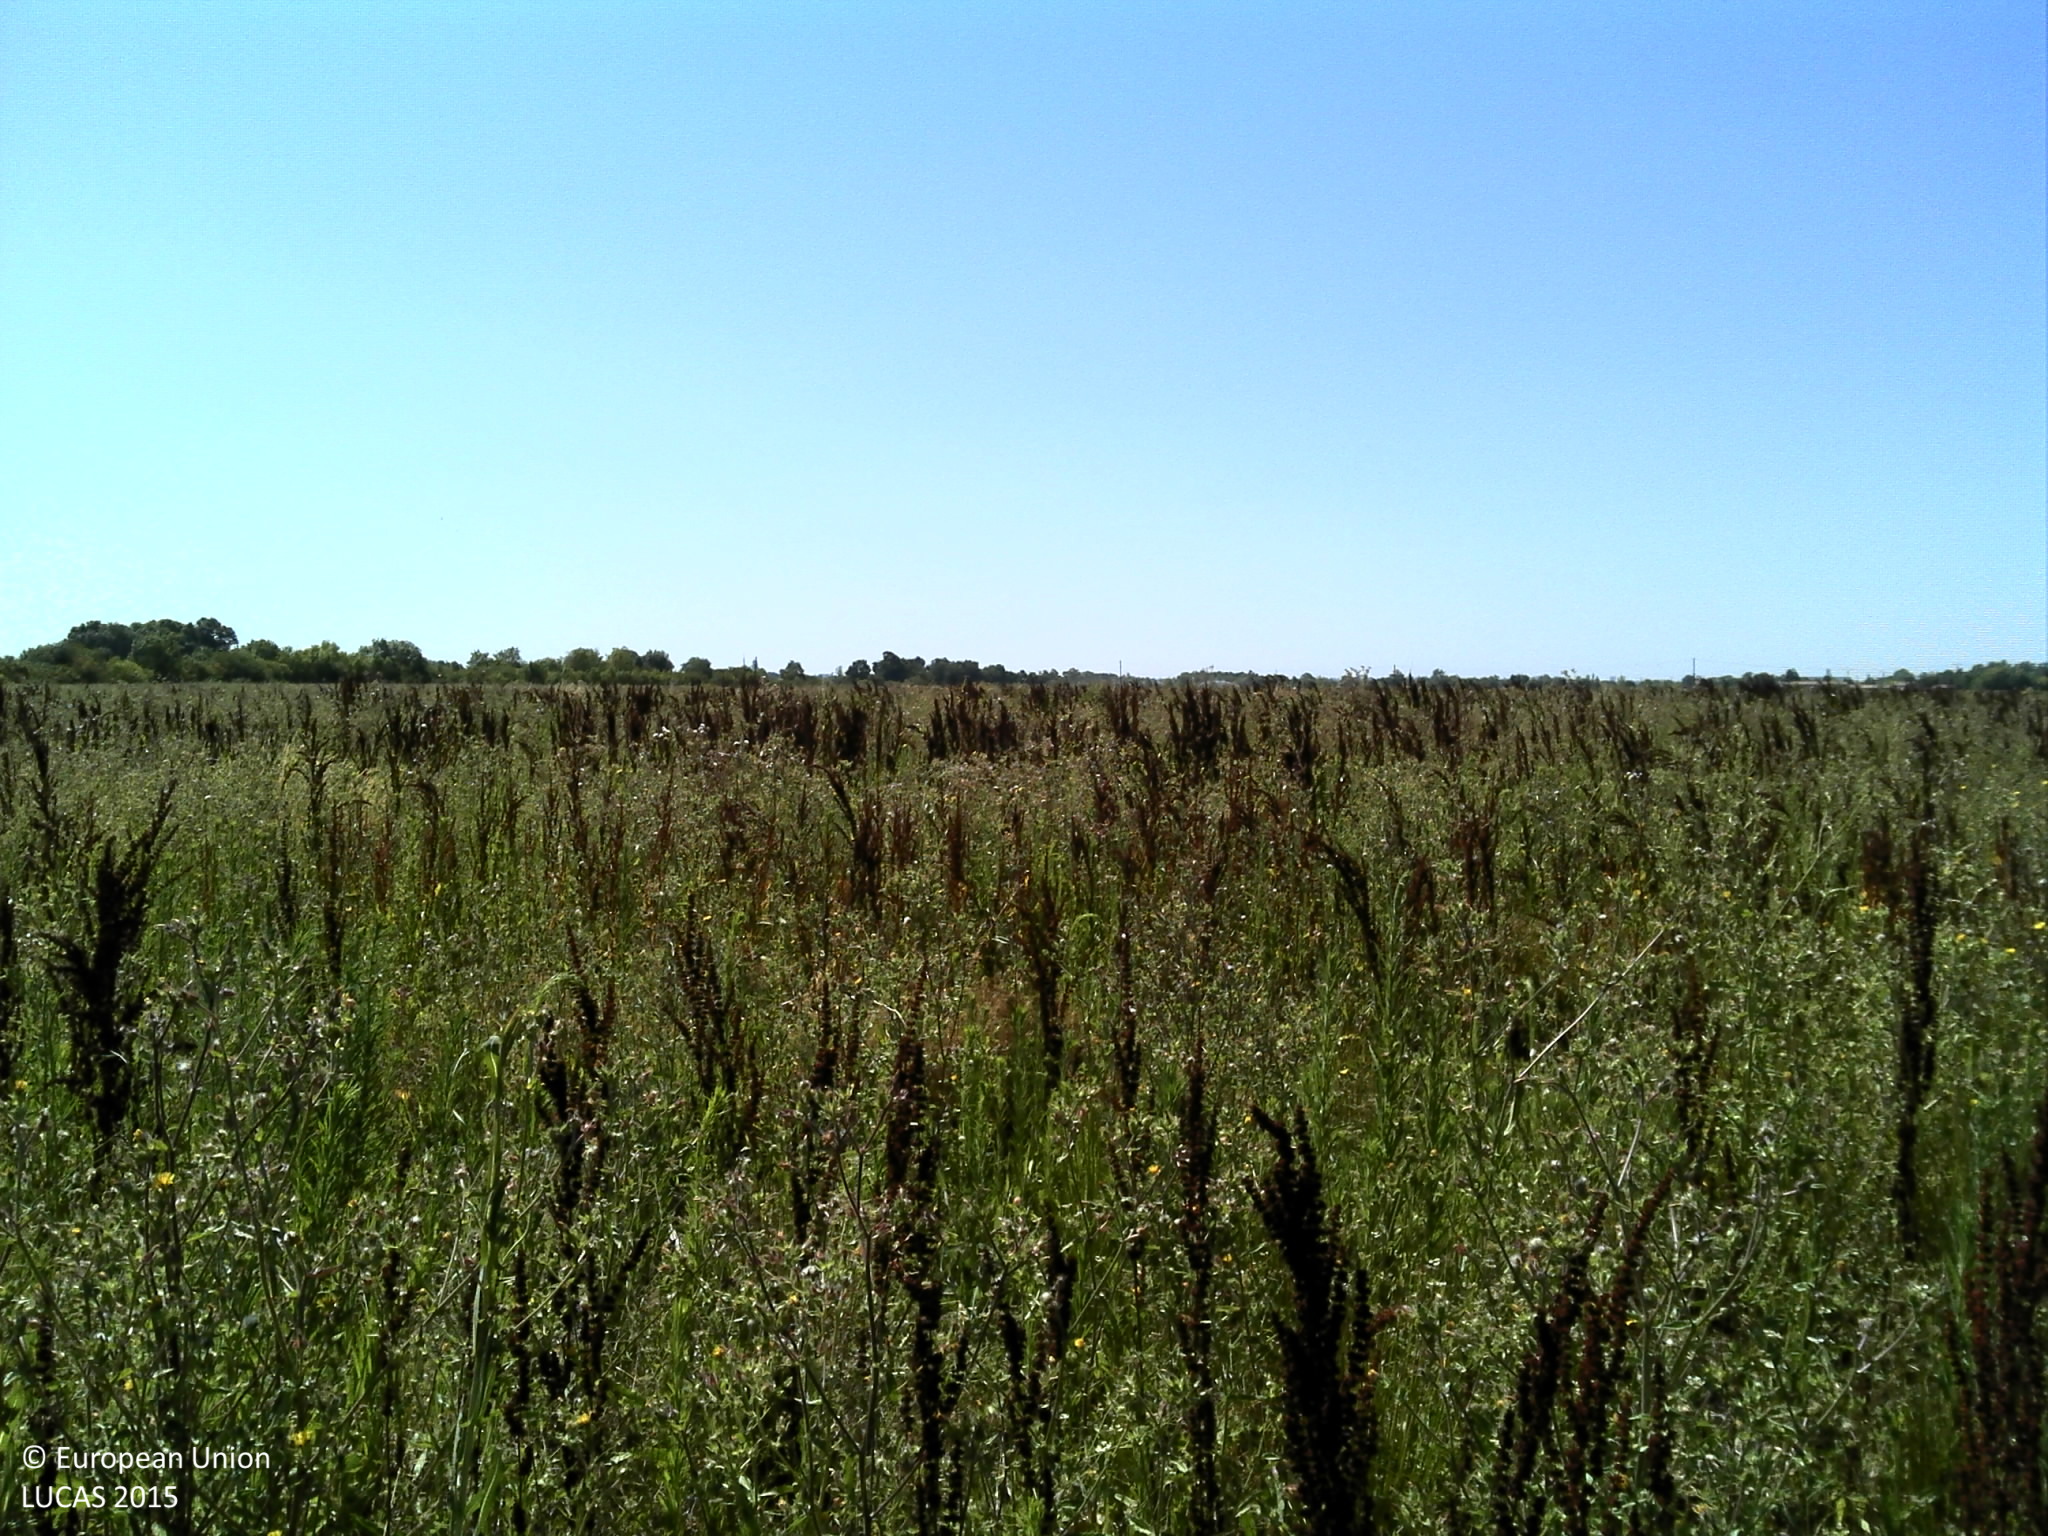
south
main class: Grassland
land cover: Spontaneously vegetated surfaces
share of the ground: > 75 %
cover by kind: herbaceous plants 100 %
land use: Fallow land
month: July
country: FR
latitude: 44.9762
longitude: -0.5311
